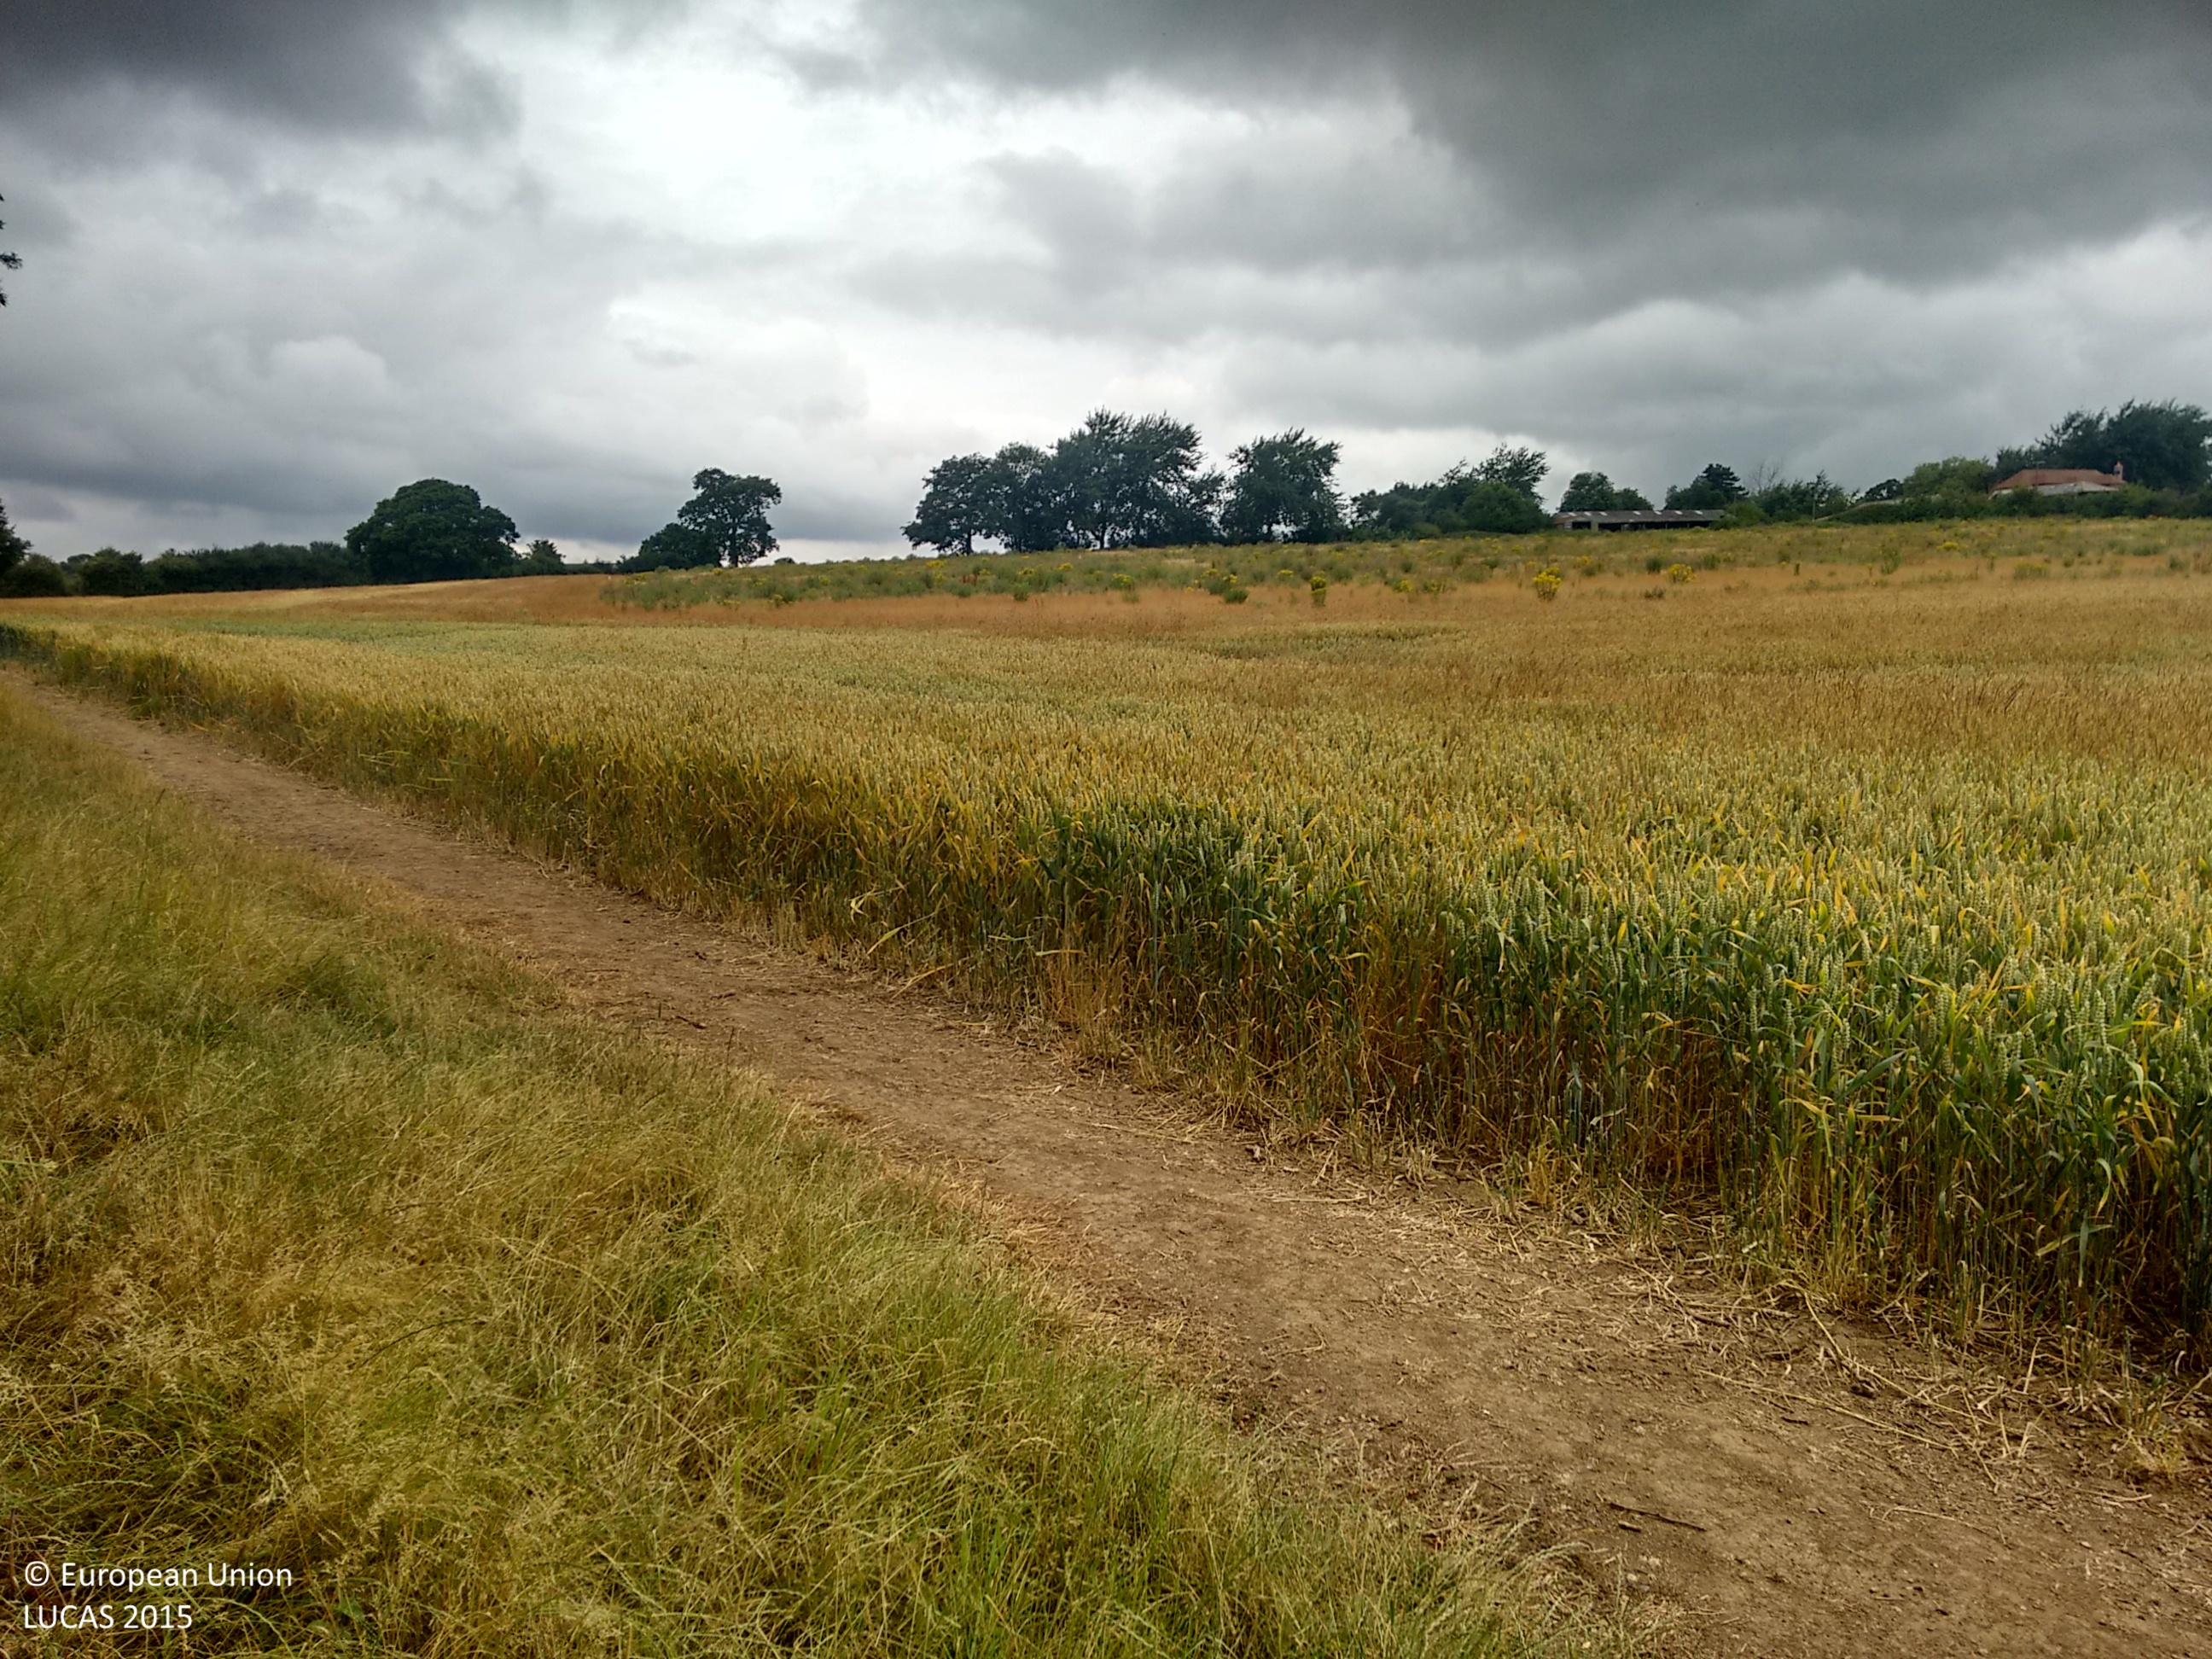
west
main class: Cropland
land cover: Common wheat
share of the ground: > 75 %
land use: Agriculture (excluding fallow land and kitchen gardens)
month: July
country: GB
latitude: 51.6390
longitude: 0.5661
